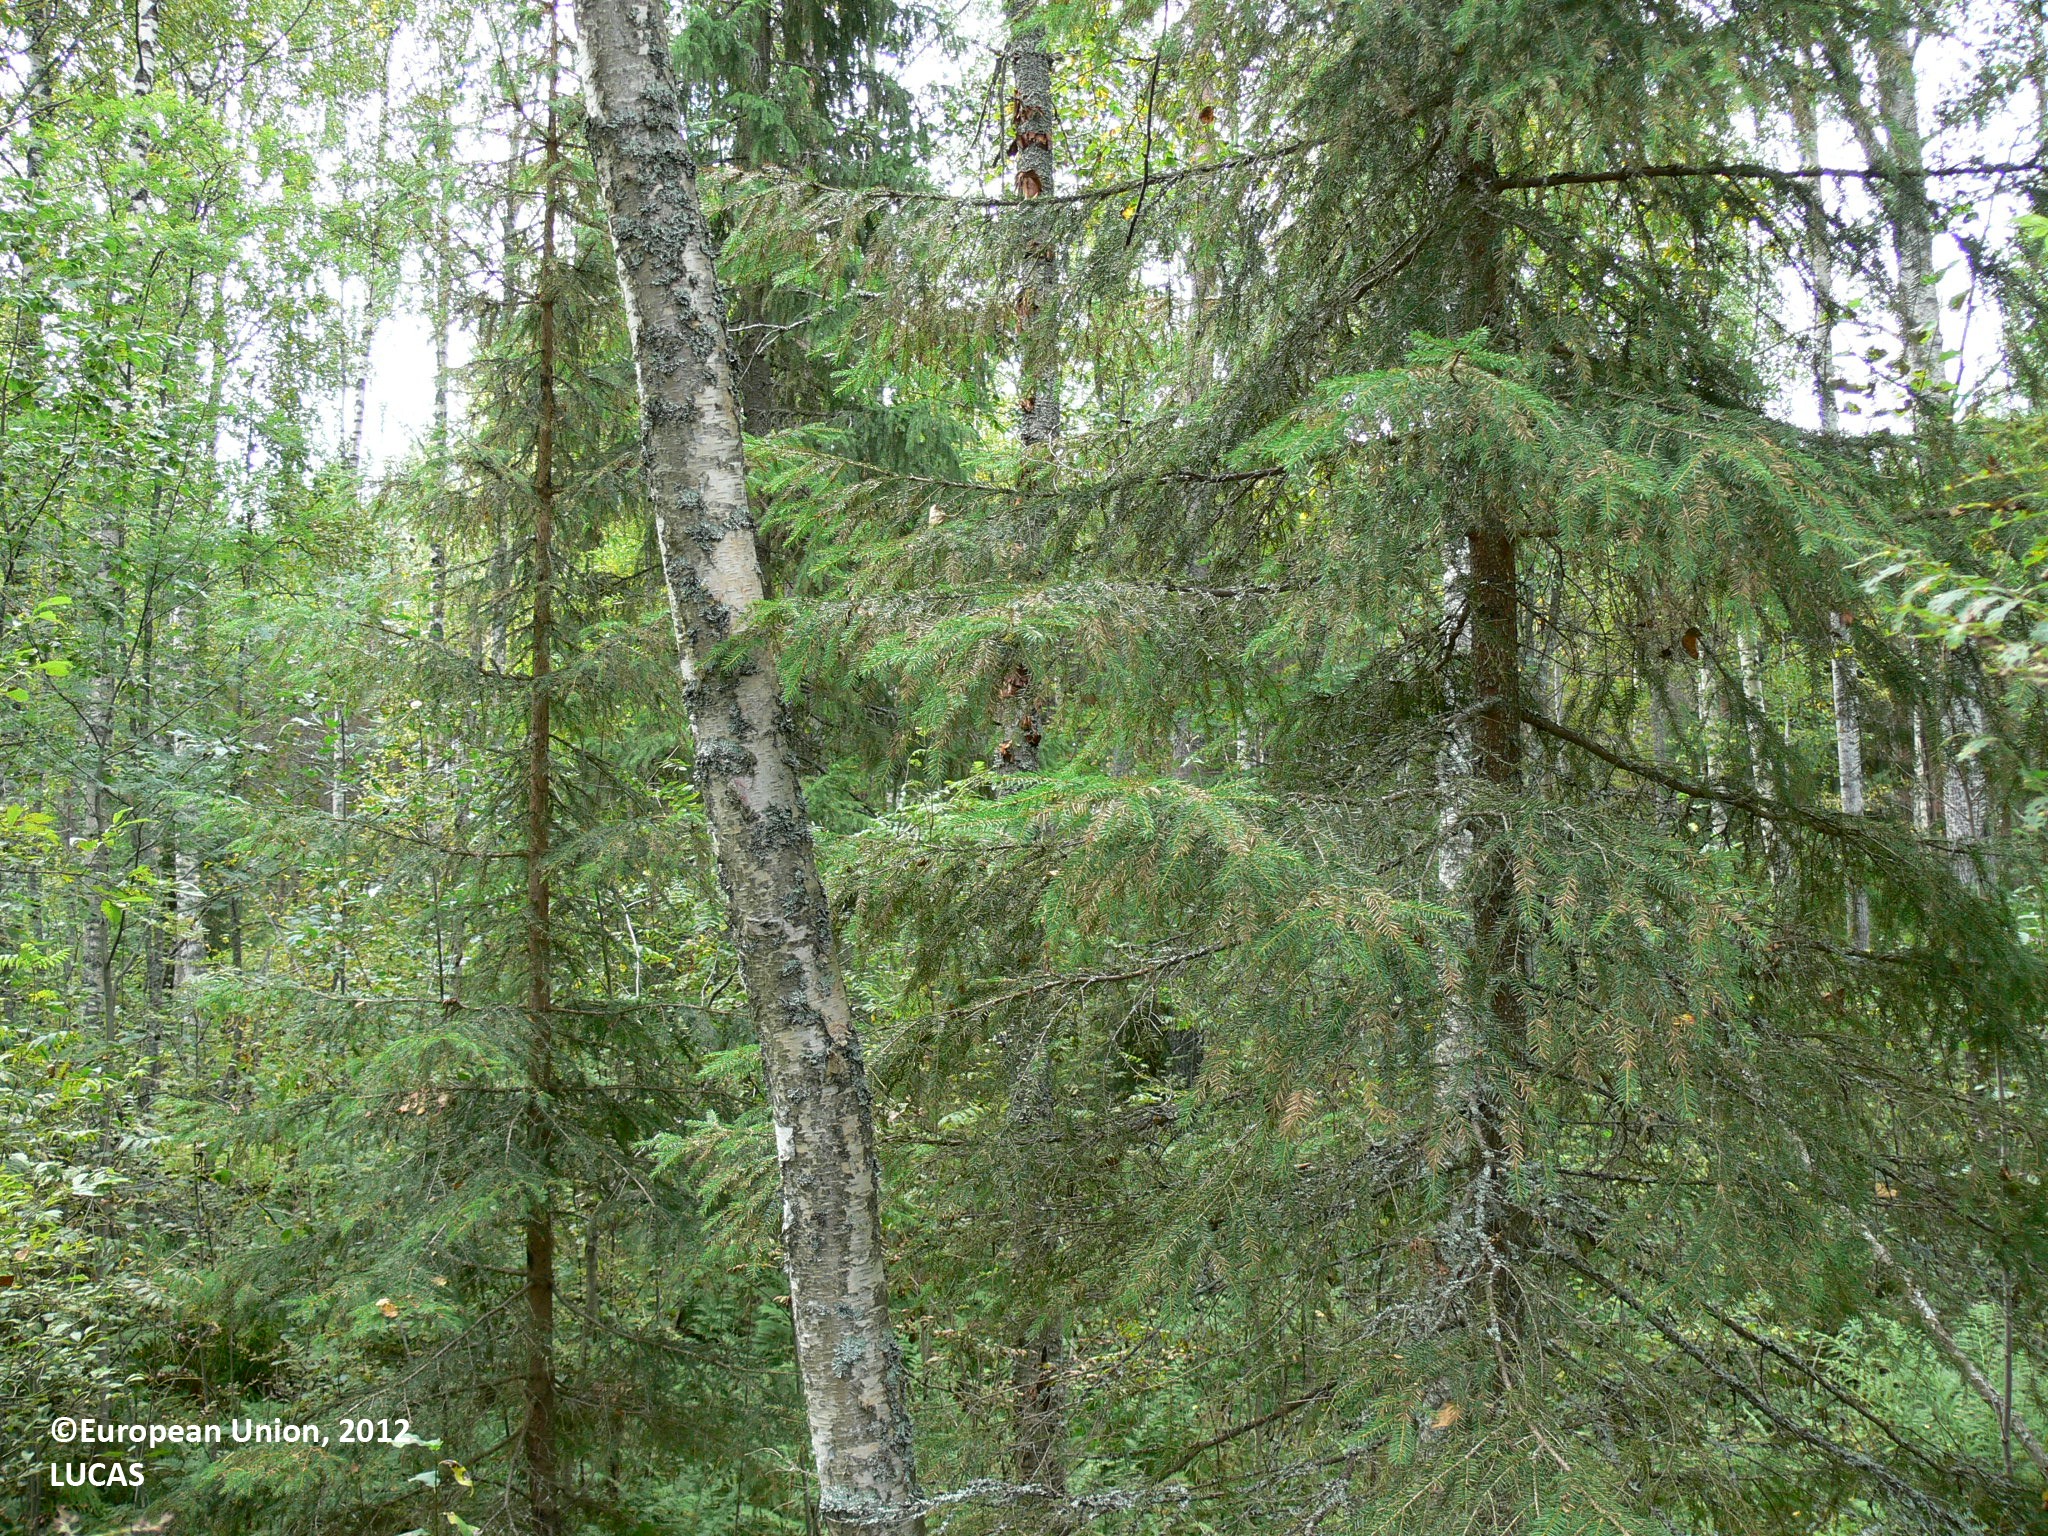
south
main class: Woodland
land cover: Other mixed woodland
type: boreal forest
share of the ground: > 75 %
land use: Forestry
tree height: > 5 m
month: August
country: FI
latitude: 62.0228
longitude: 30.2046
